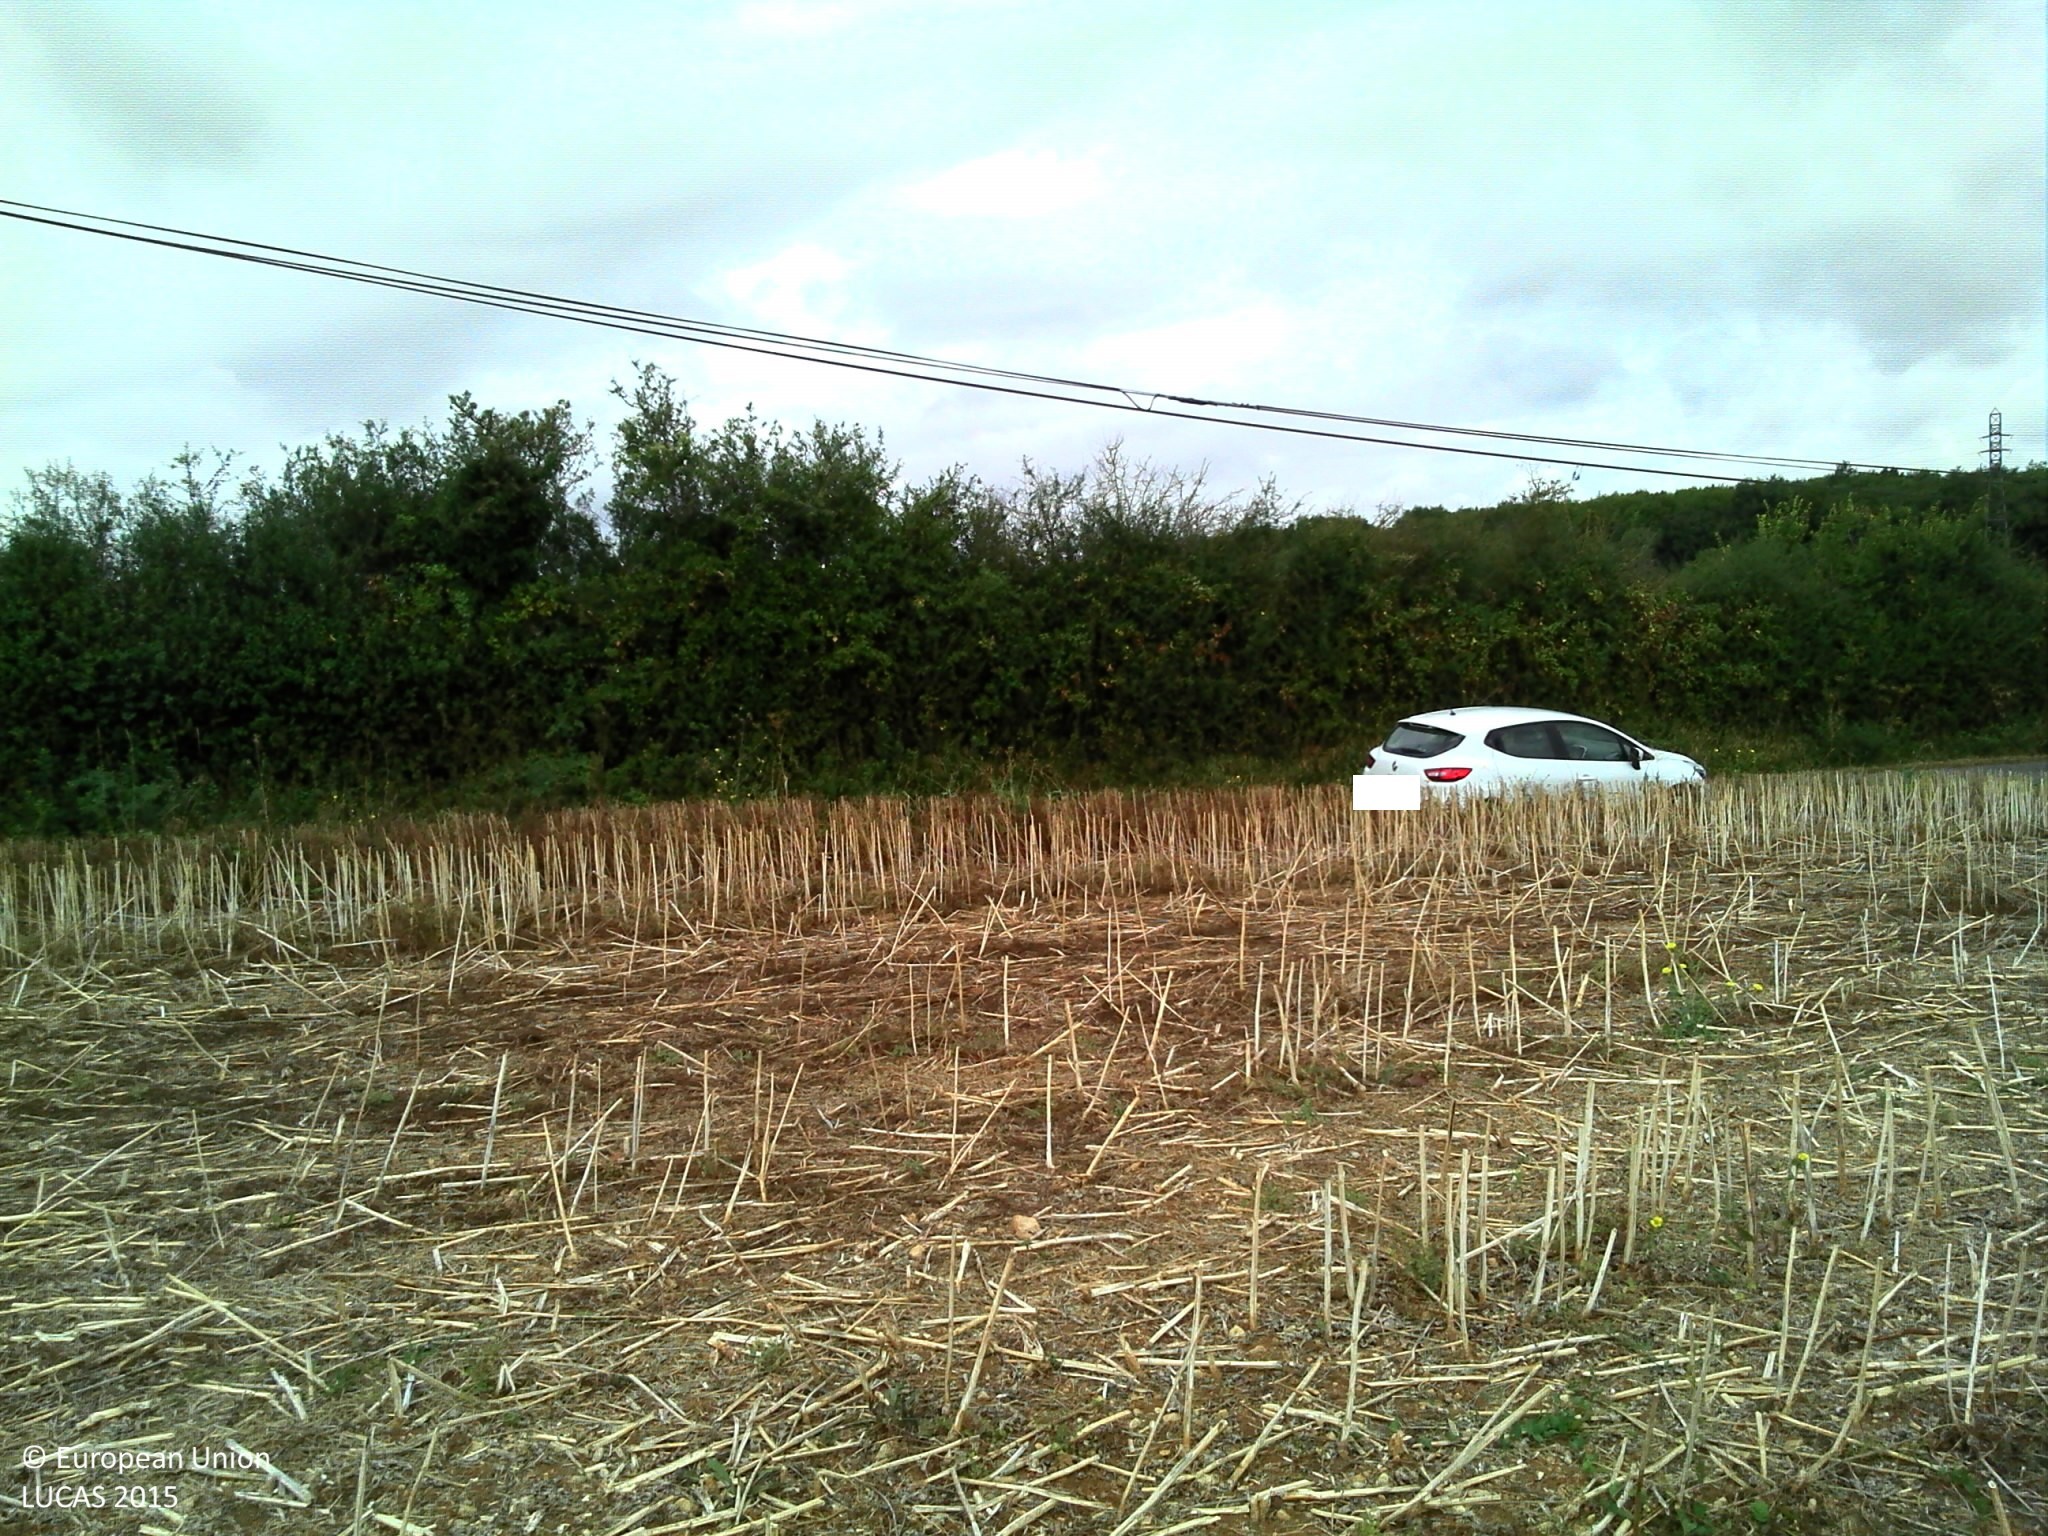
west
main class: Cropland
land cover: Rape and turnip rape
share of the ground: < 10 %
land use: Agriculture (excluding fallow land and kitchen gardens)
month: July
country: FR
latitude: 46.3269
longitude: 0.3048
